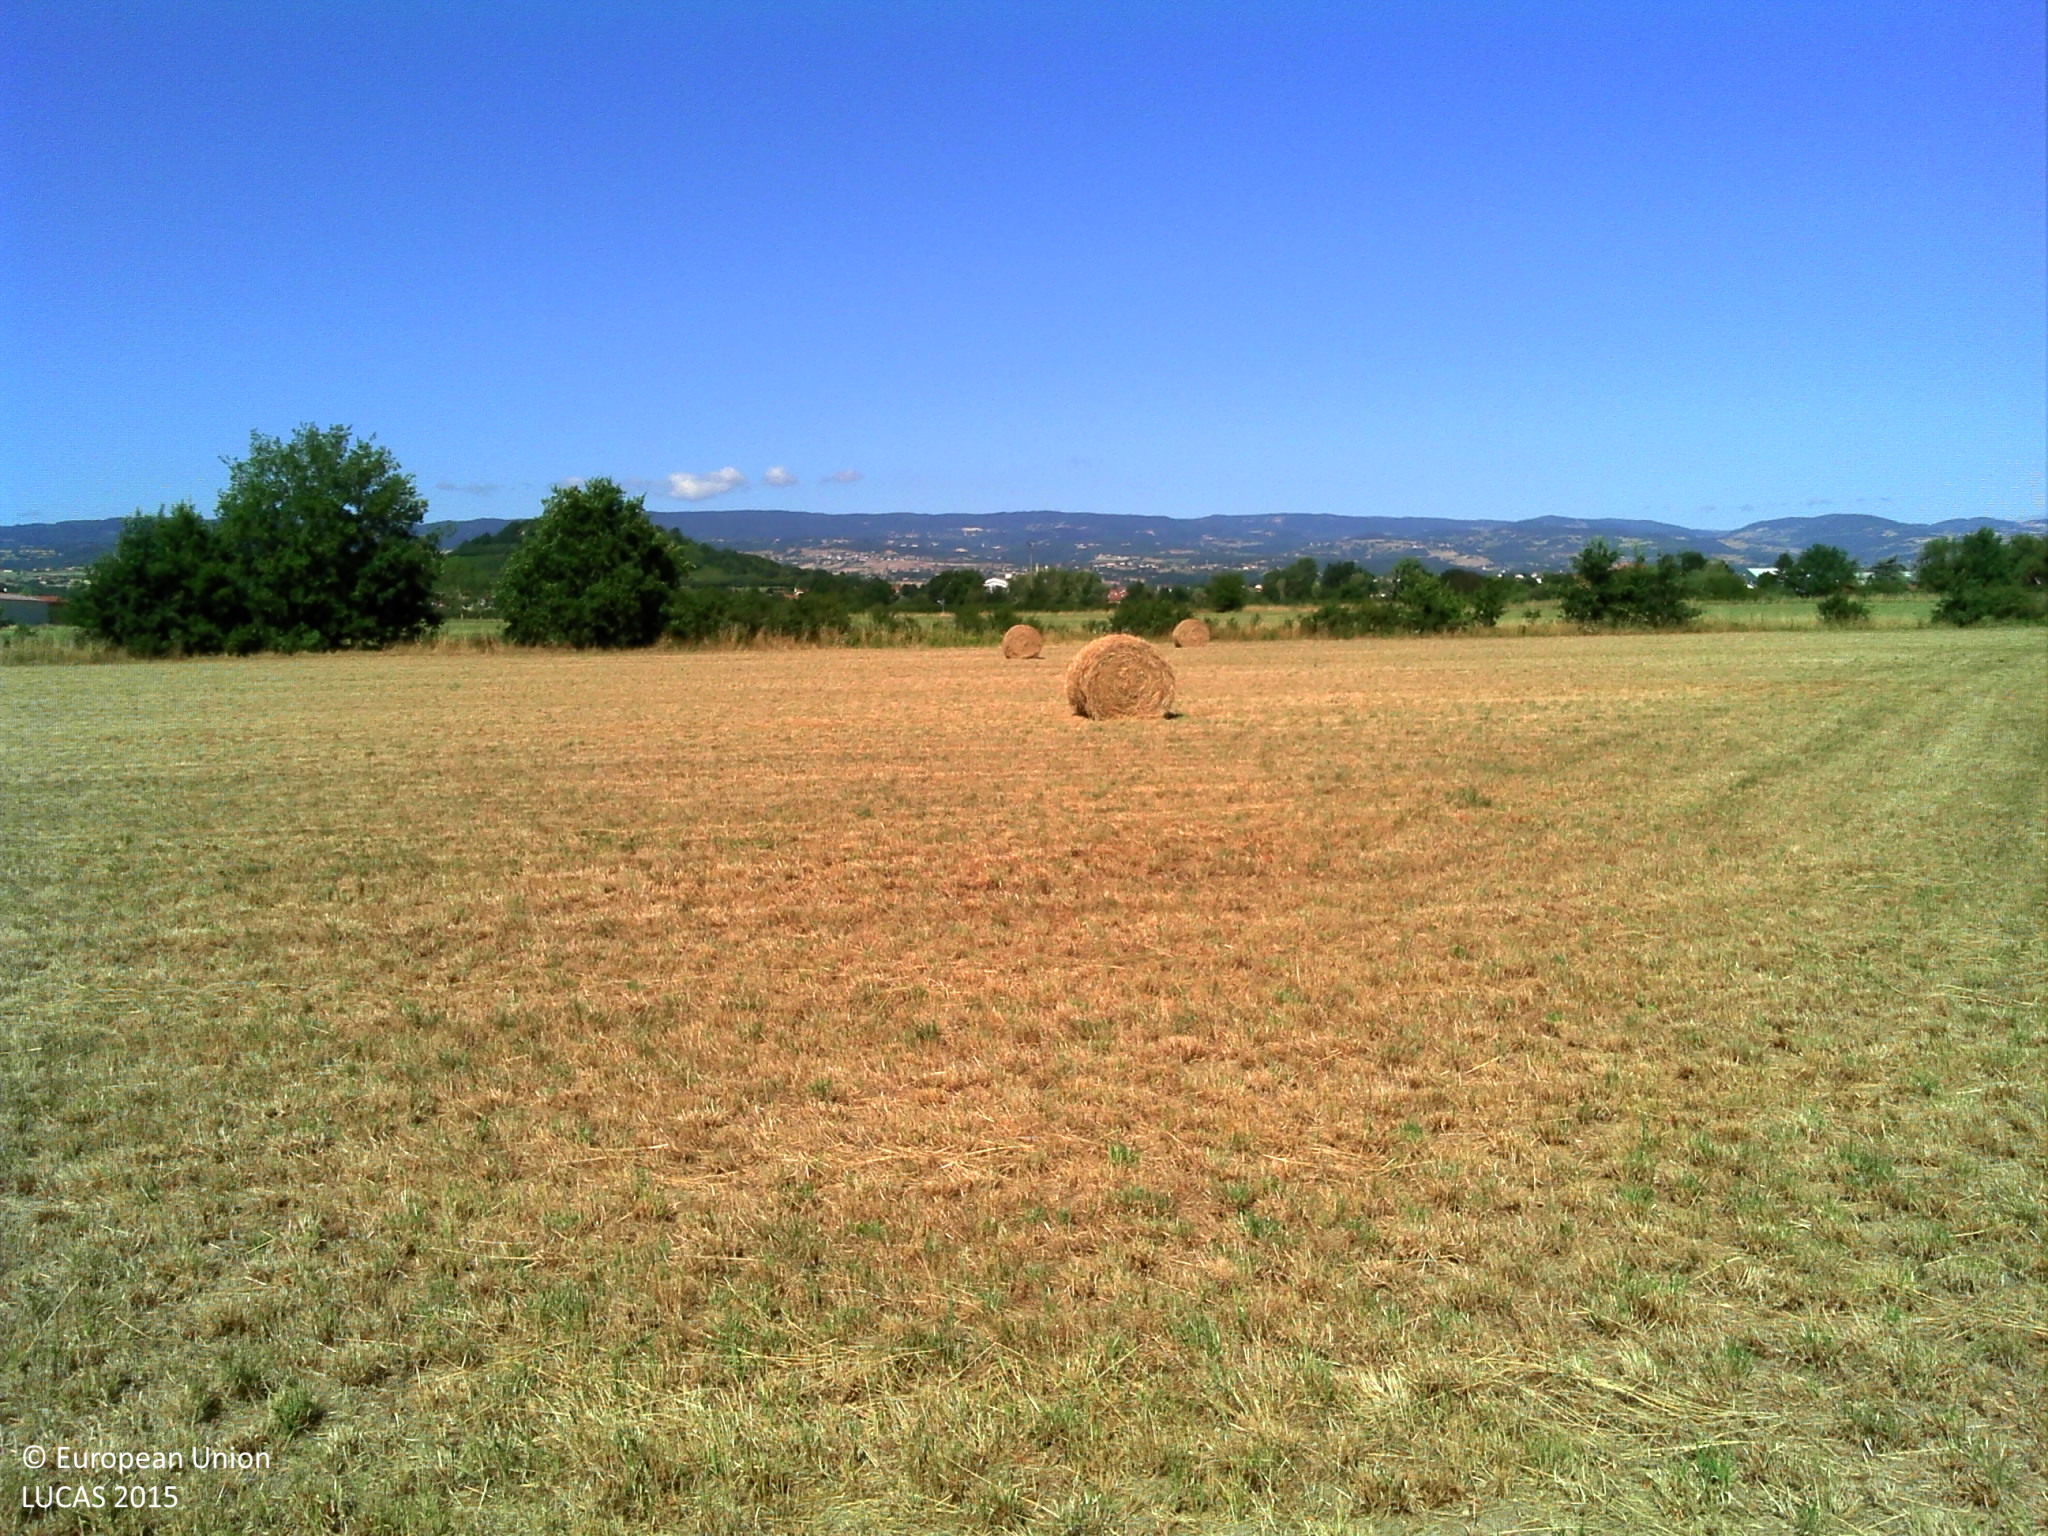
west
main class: Woodland
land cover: Broadleaved woodland
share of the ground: > 75 %
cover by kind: broadleaved forest trees 85 %, shrubs 5 %, herbaceous plants 5 %, lichens and mosses 5 %
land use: Semi-natural and natural areas not in use
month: July
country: FR
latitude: 45.5589
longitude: 4.1484
